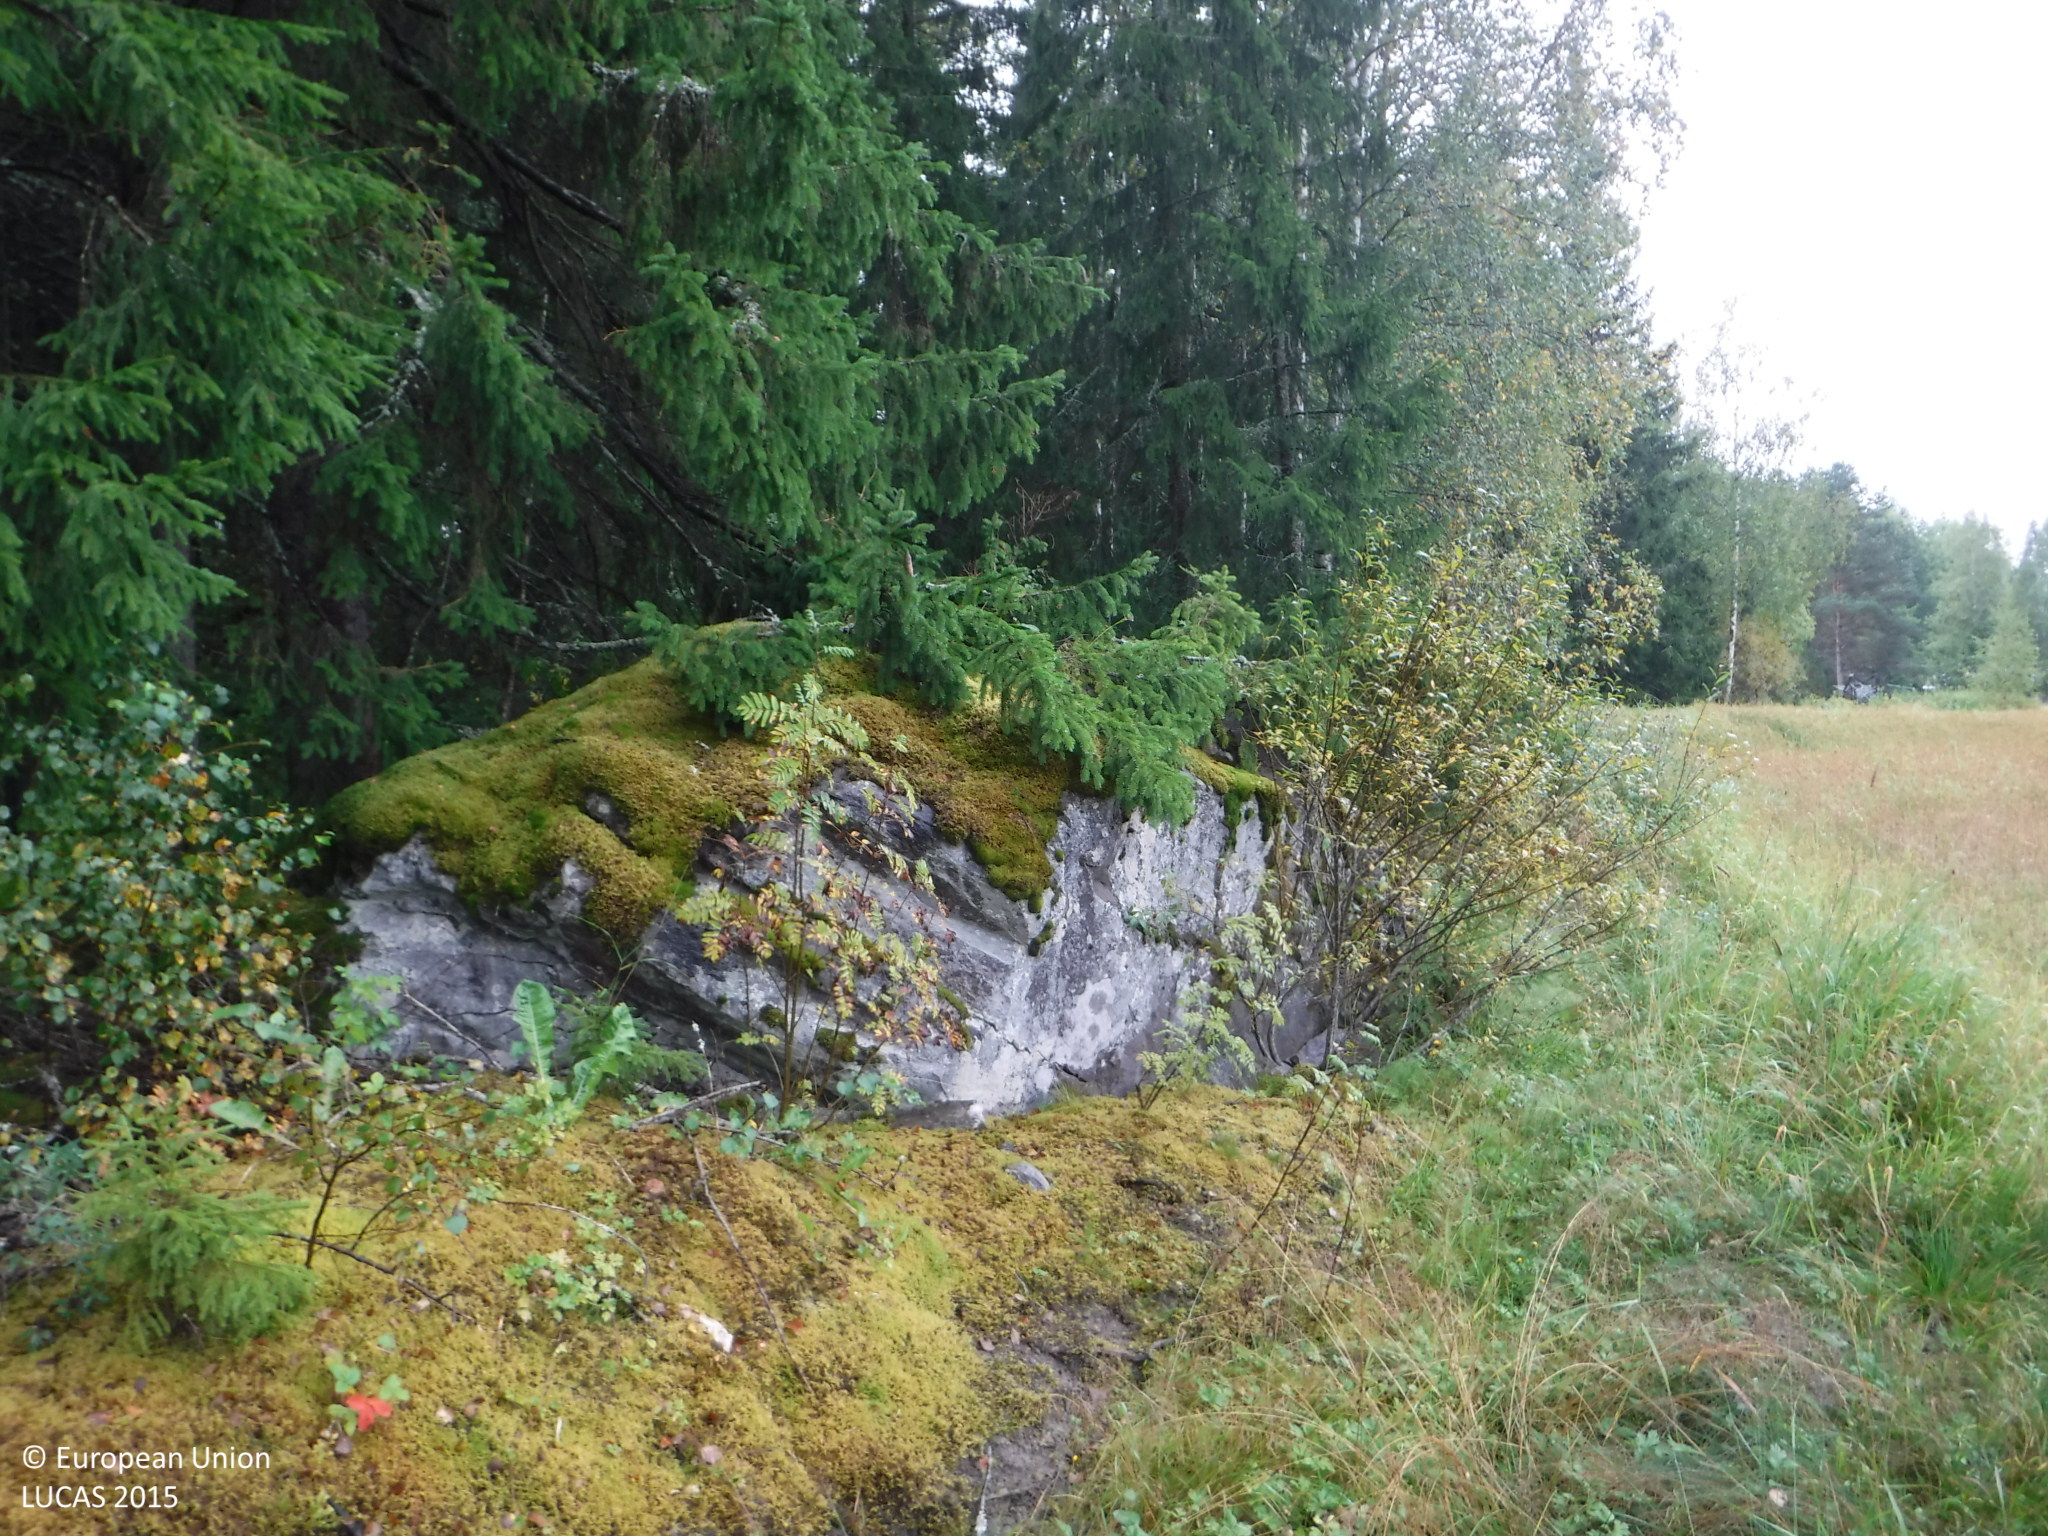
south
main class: Cropland
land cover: Common wheat
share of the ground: > 75 %
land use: Agriculture (excluding fallow land and kitchen gardens)
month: September
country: FI
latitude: 61.3298
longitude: 23.0212
